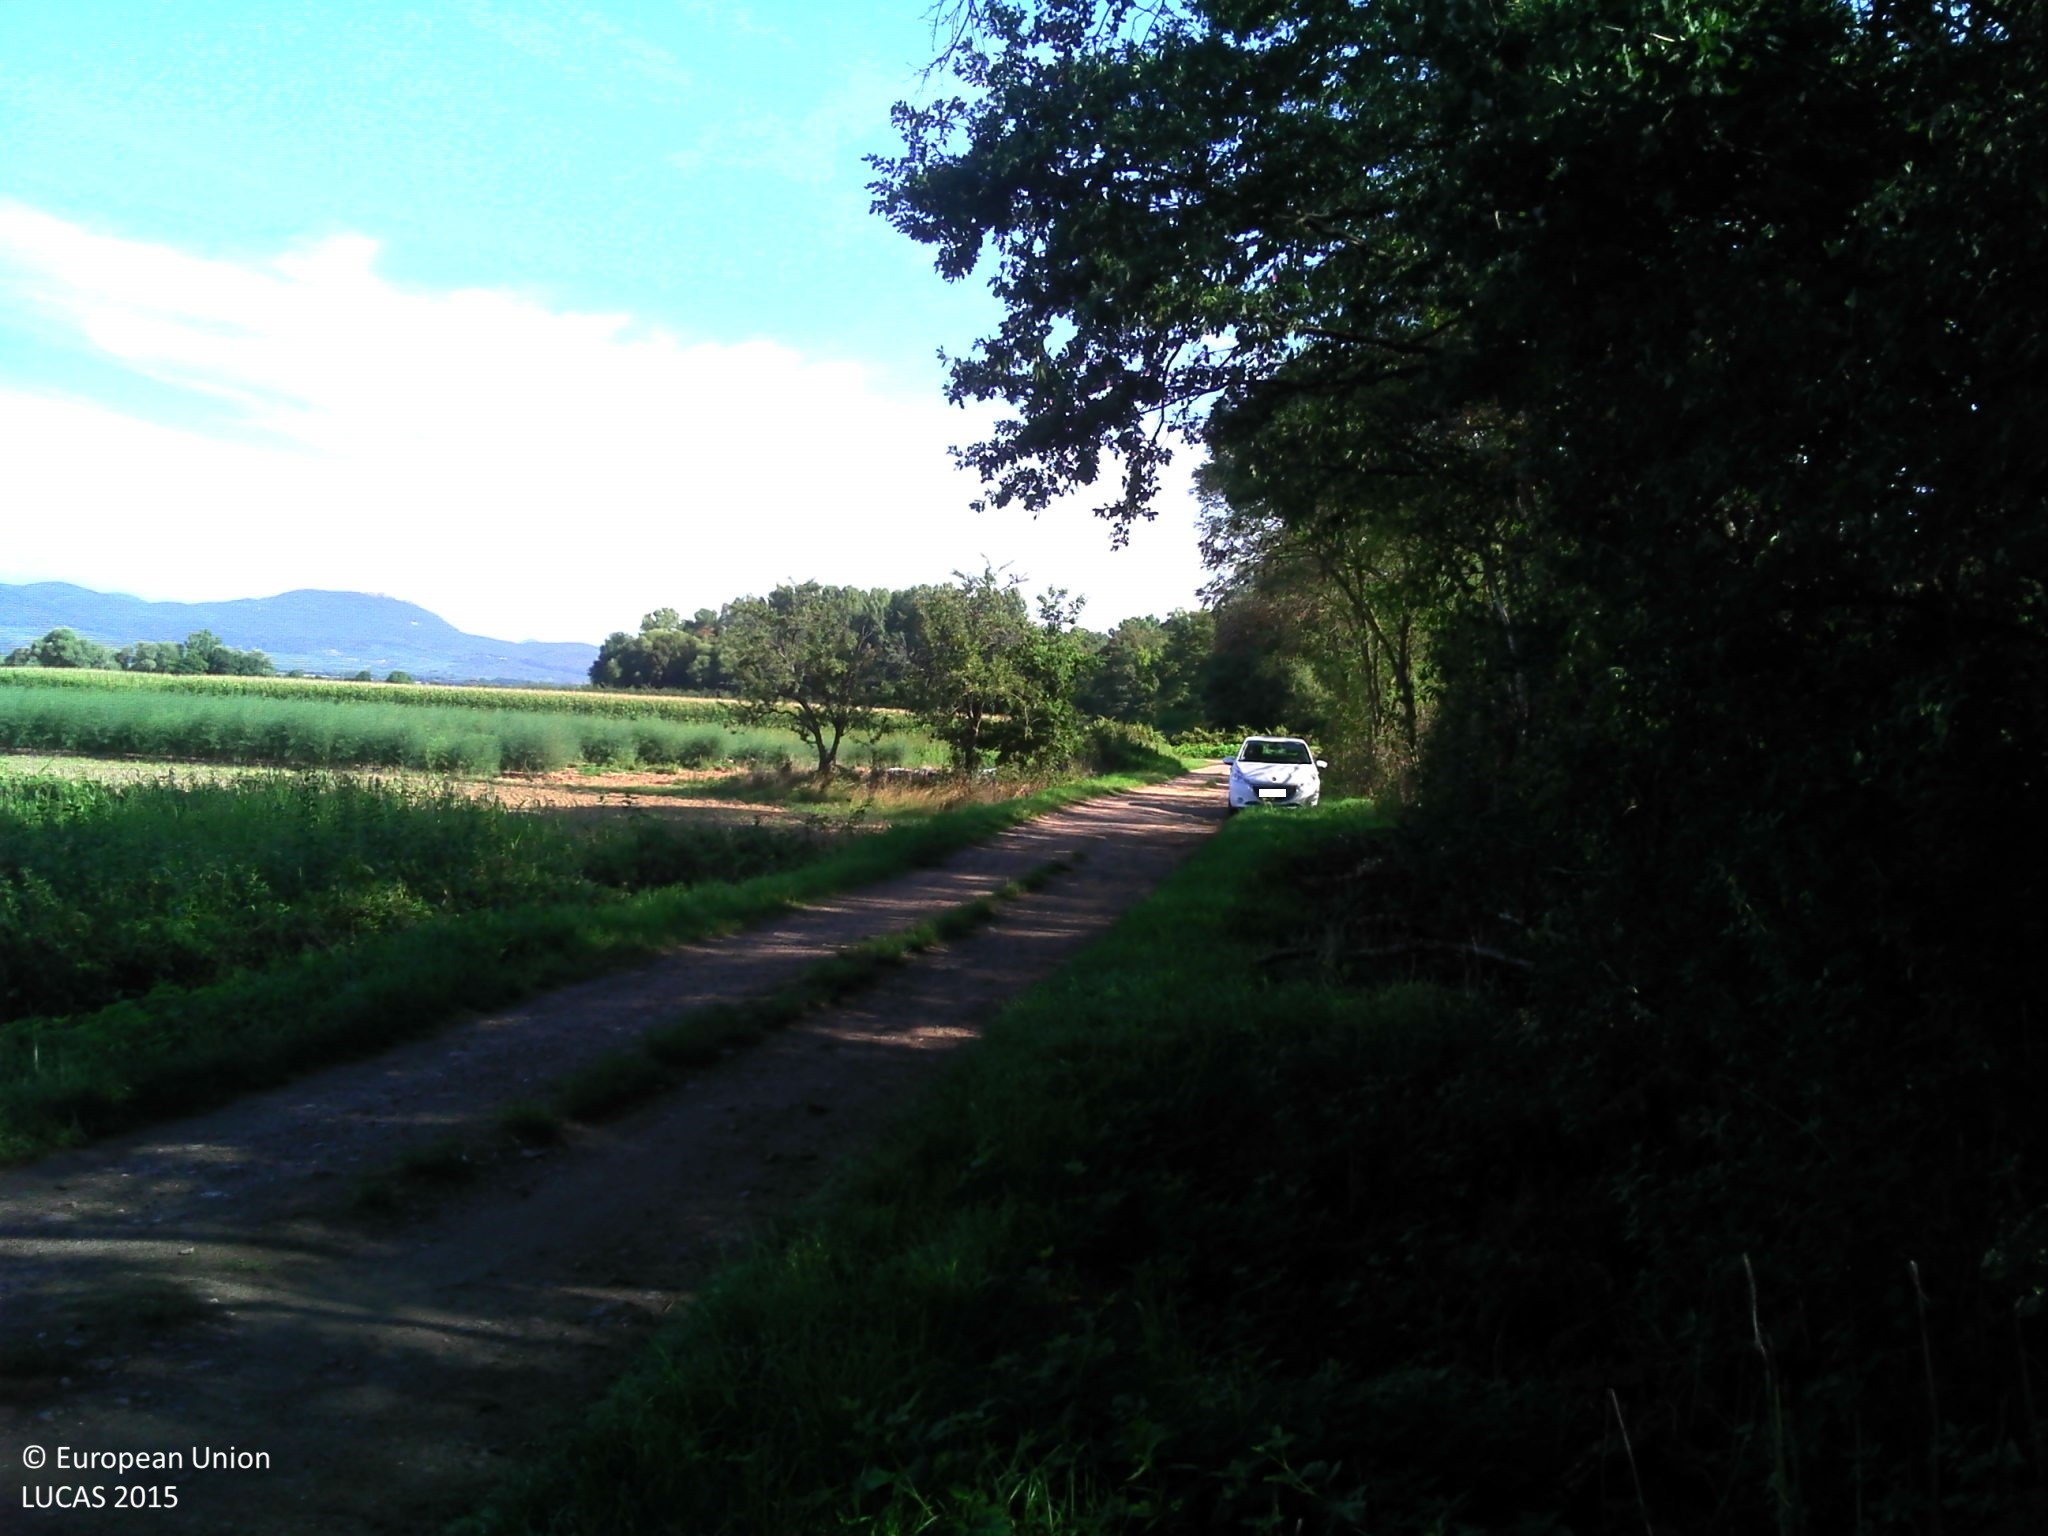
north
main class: Woodland
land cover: Broadleaved woodland
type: mesophytic deciduous forest
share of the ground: > 75 %
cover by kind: broadleaved forest trees 100 %
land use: Semi-natural and natural areas not in use
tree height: > 5 m
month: August
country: FR
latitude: 48.1378
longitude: 7.3538
